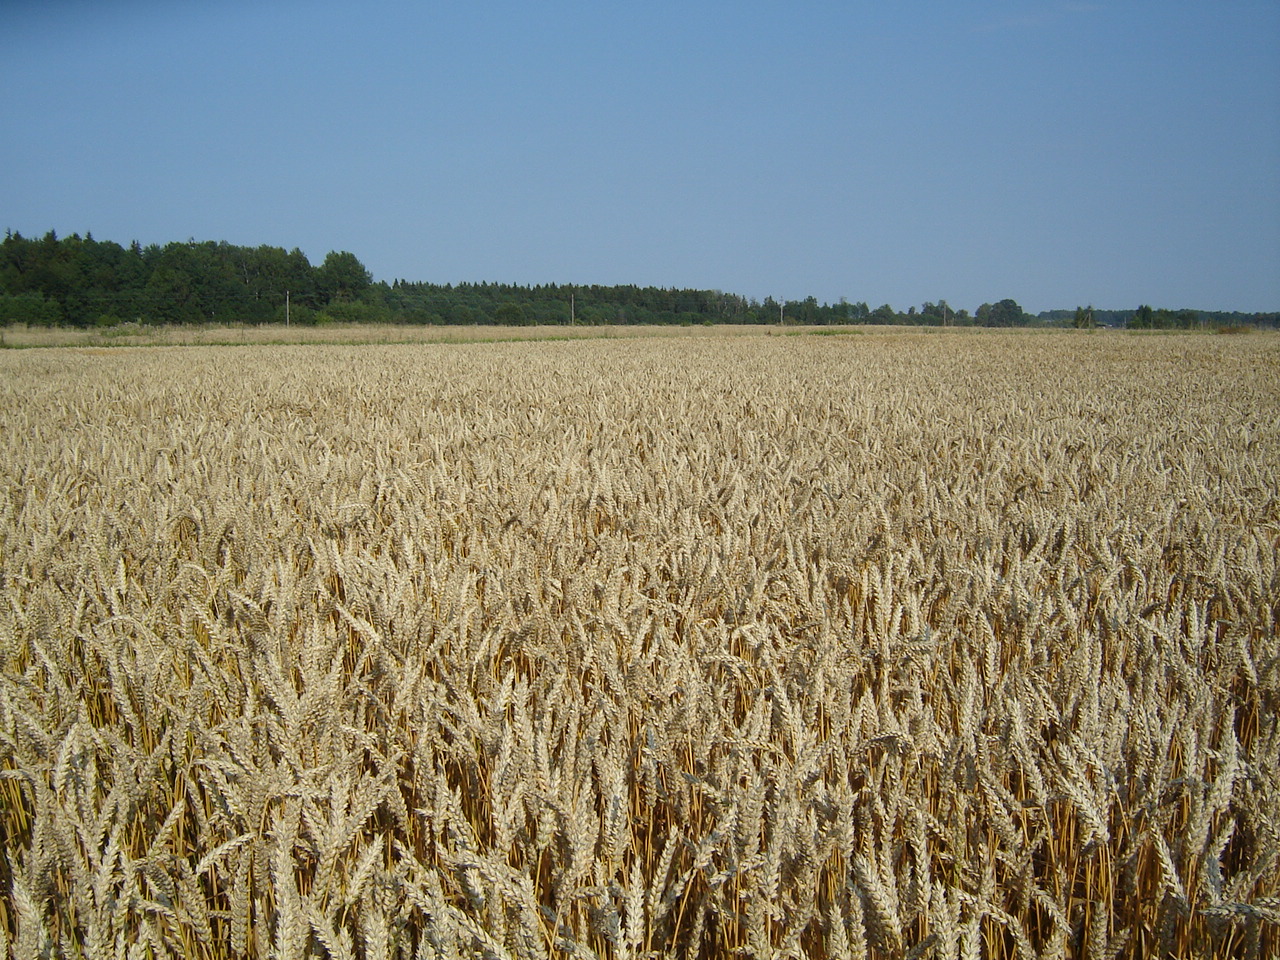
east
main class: Cropland
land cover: Common wheat
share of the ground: > 75 %
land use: Agriculture (excluding fallow land and kitchen gardens)
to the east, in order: Common wheat; Grass margins; Paved roads, cycling and walking lanes; Grass margins; Common wheat; Shruby margins; Grass margins; Paved roads, cycling and walking lanes; Grass margins; Abandoned hedges
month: August
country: LT
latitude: 55.0852
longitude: 24.9479
